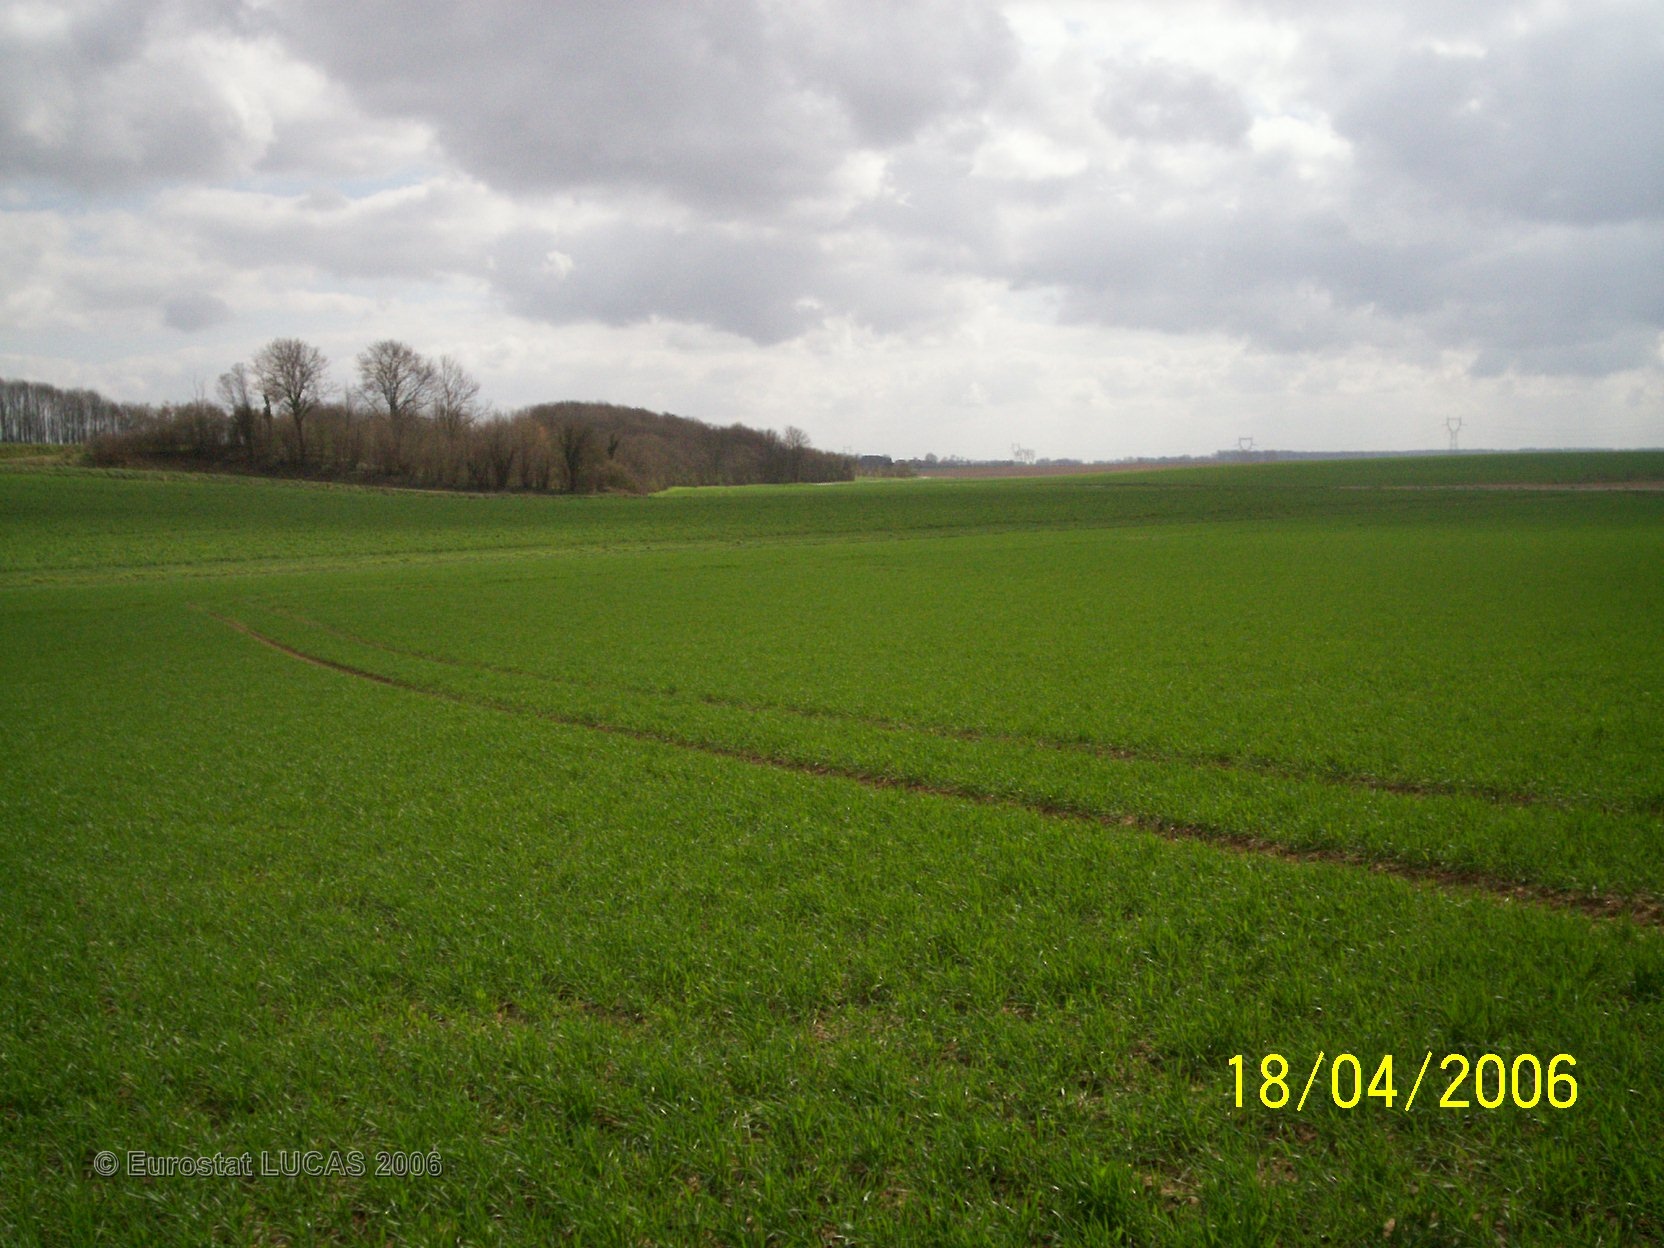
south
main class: Cropland
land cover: Common wheat
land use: Agriculture (excluding fallow land and kitchen gardens)
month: April
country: FR
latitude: 50.3362
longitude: 2.5272
